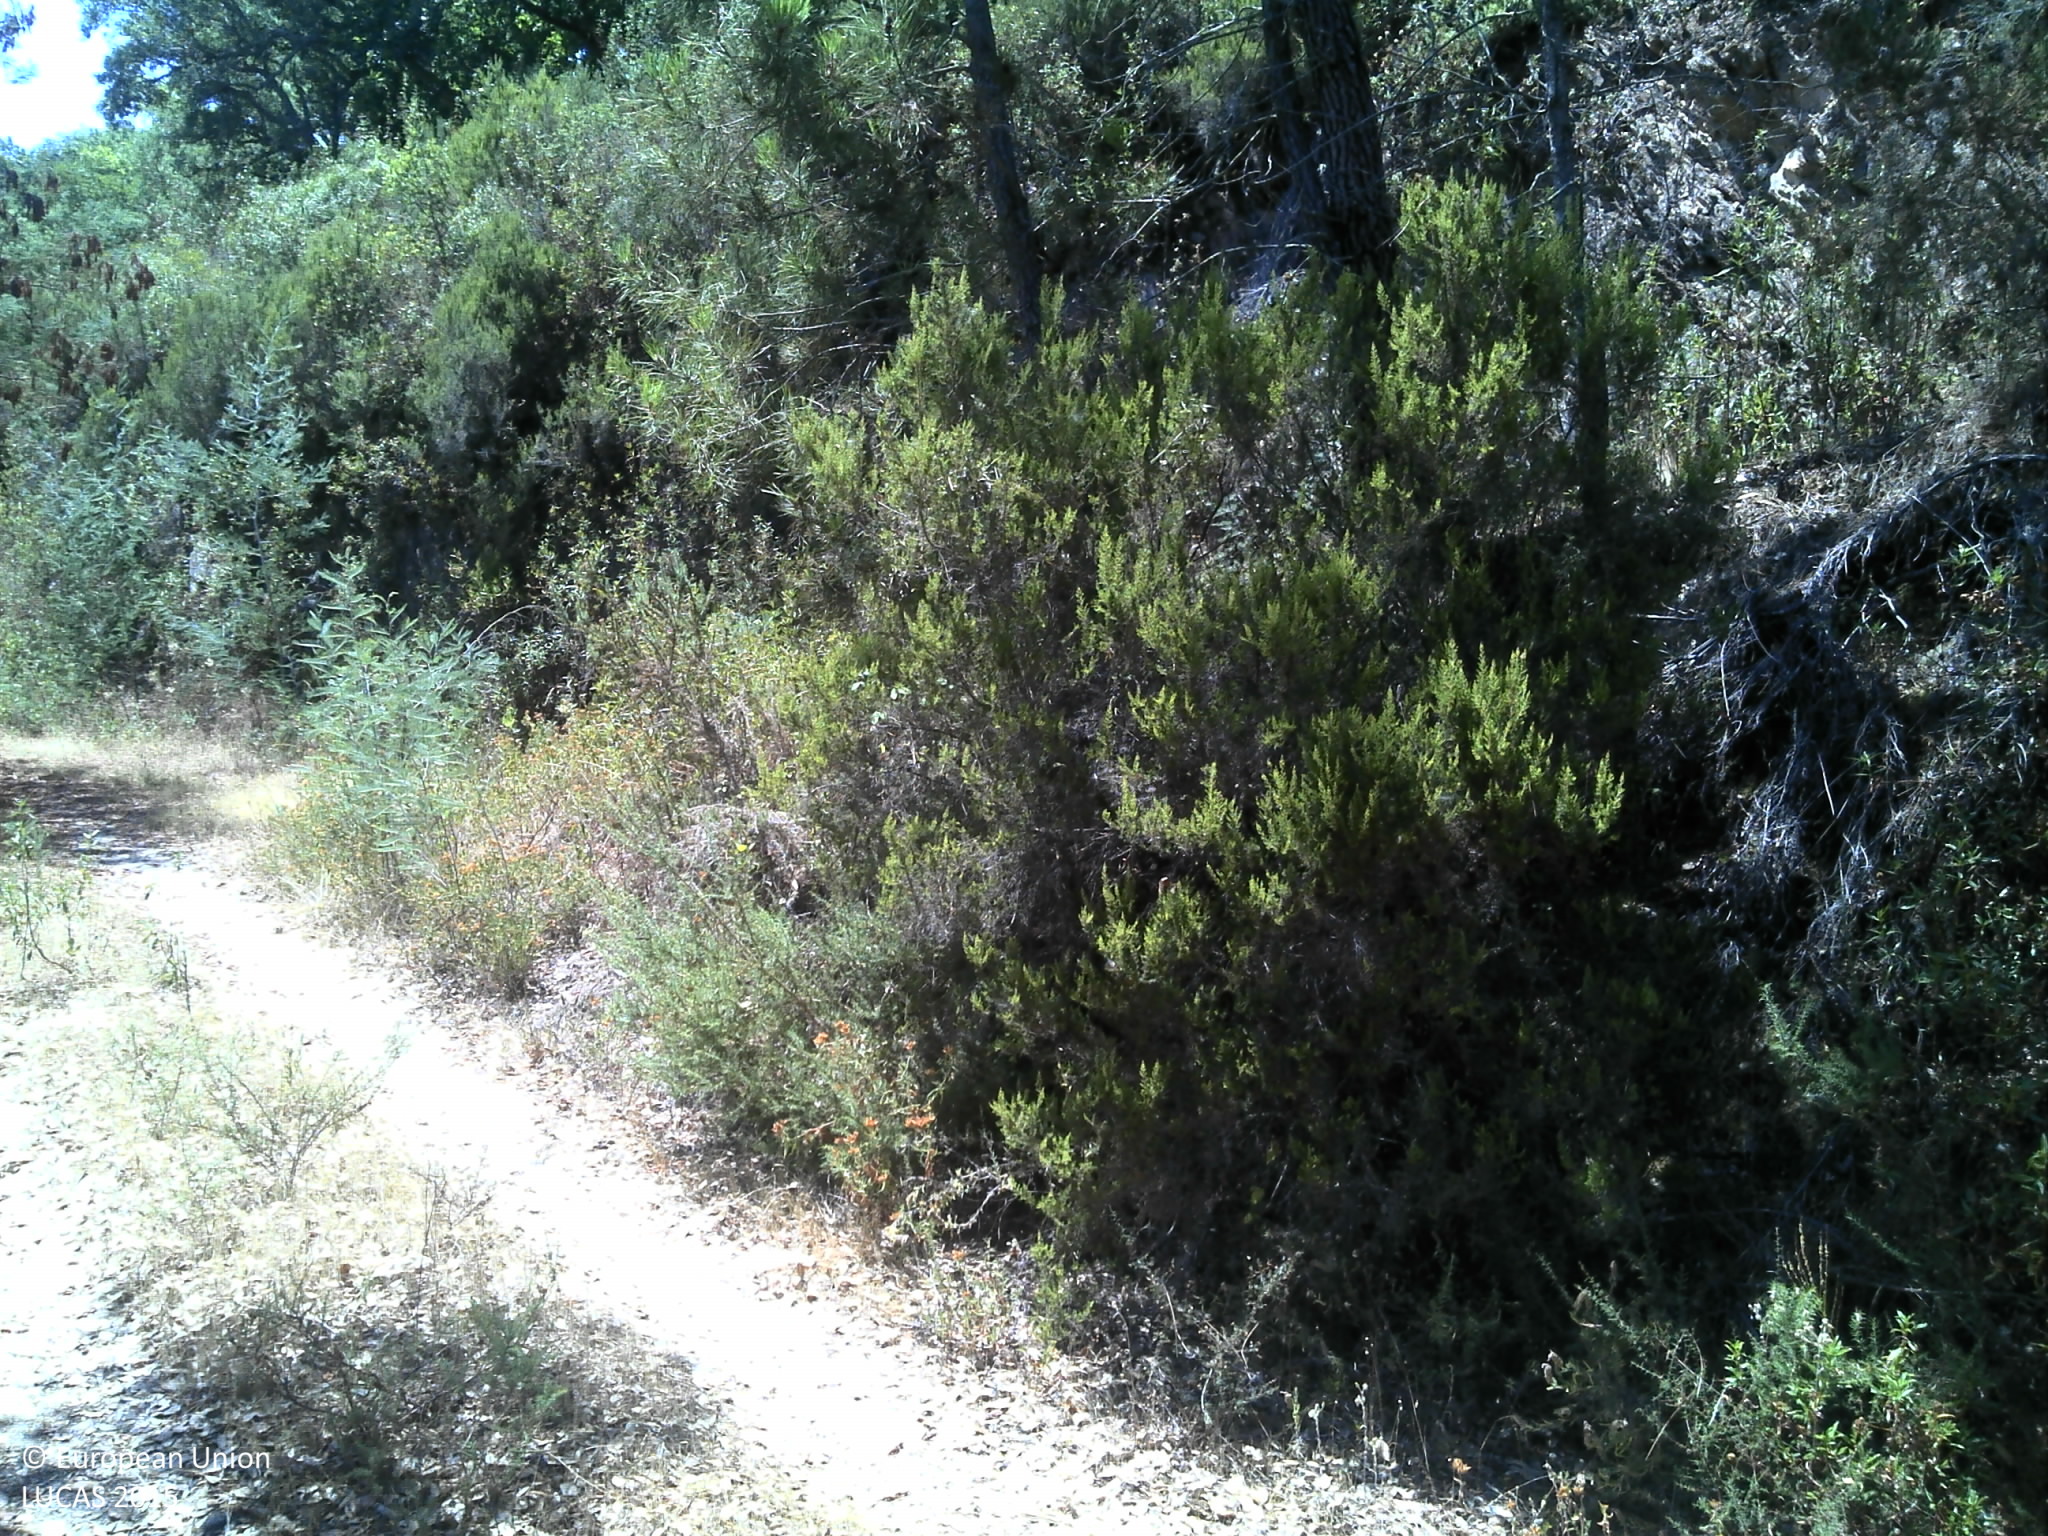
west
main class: Woodland
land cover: Broadleaved woodland
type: broadleaved evergreen forest
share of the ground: 25 - 50 %
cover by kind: broadleaved forest trees 50 %, shrubs 40 %, unconsolidated bare surface 10 %
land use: Semi-natural and natural areas not in use
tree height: > 5 m
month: July
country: PT
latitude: 40.3382
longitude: -8.2200
